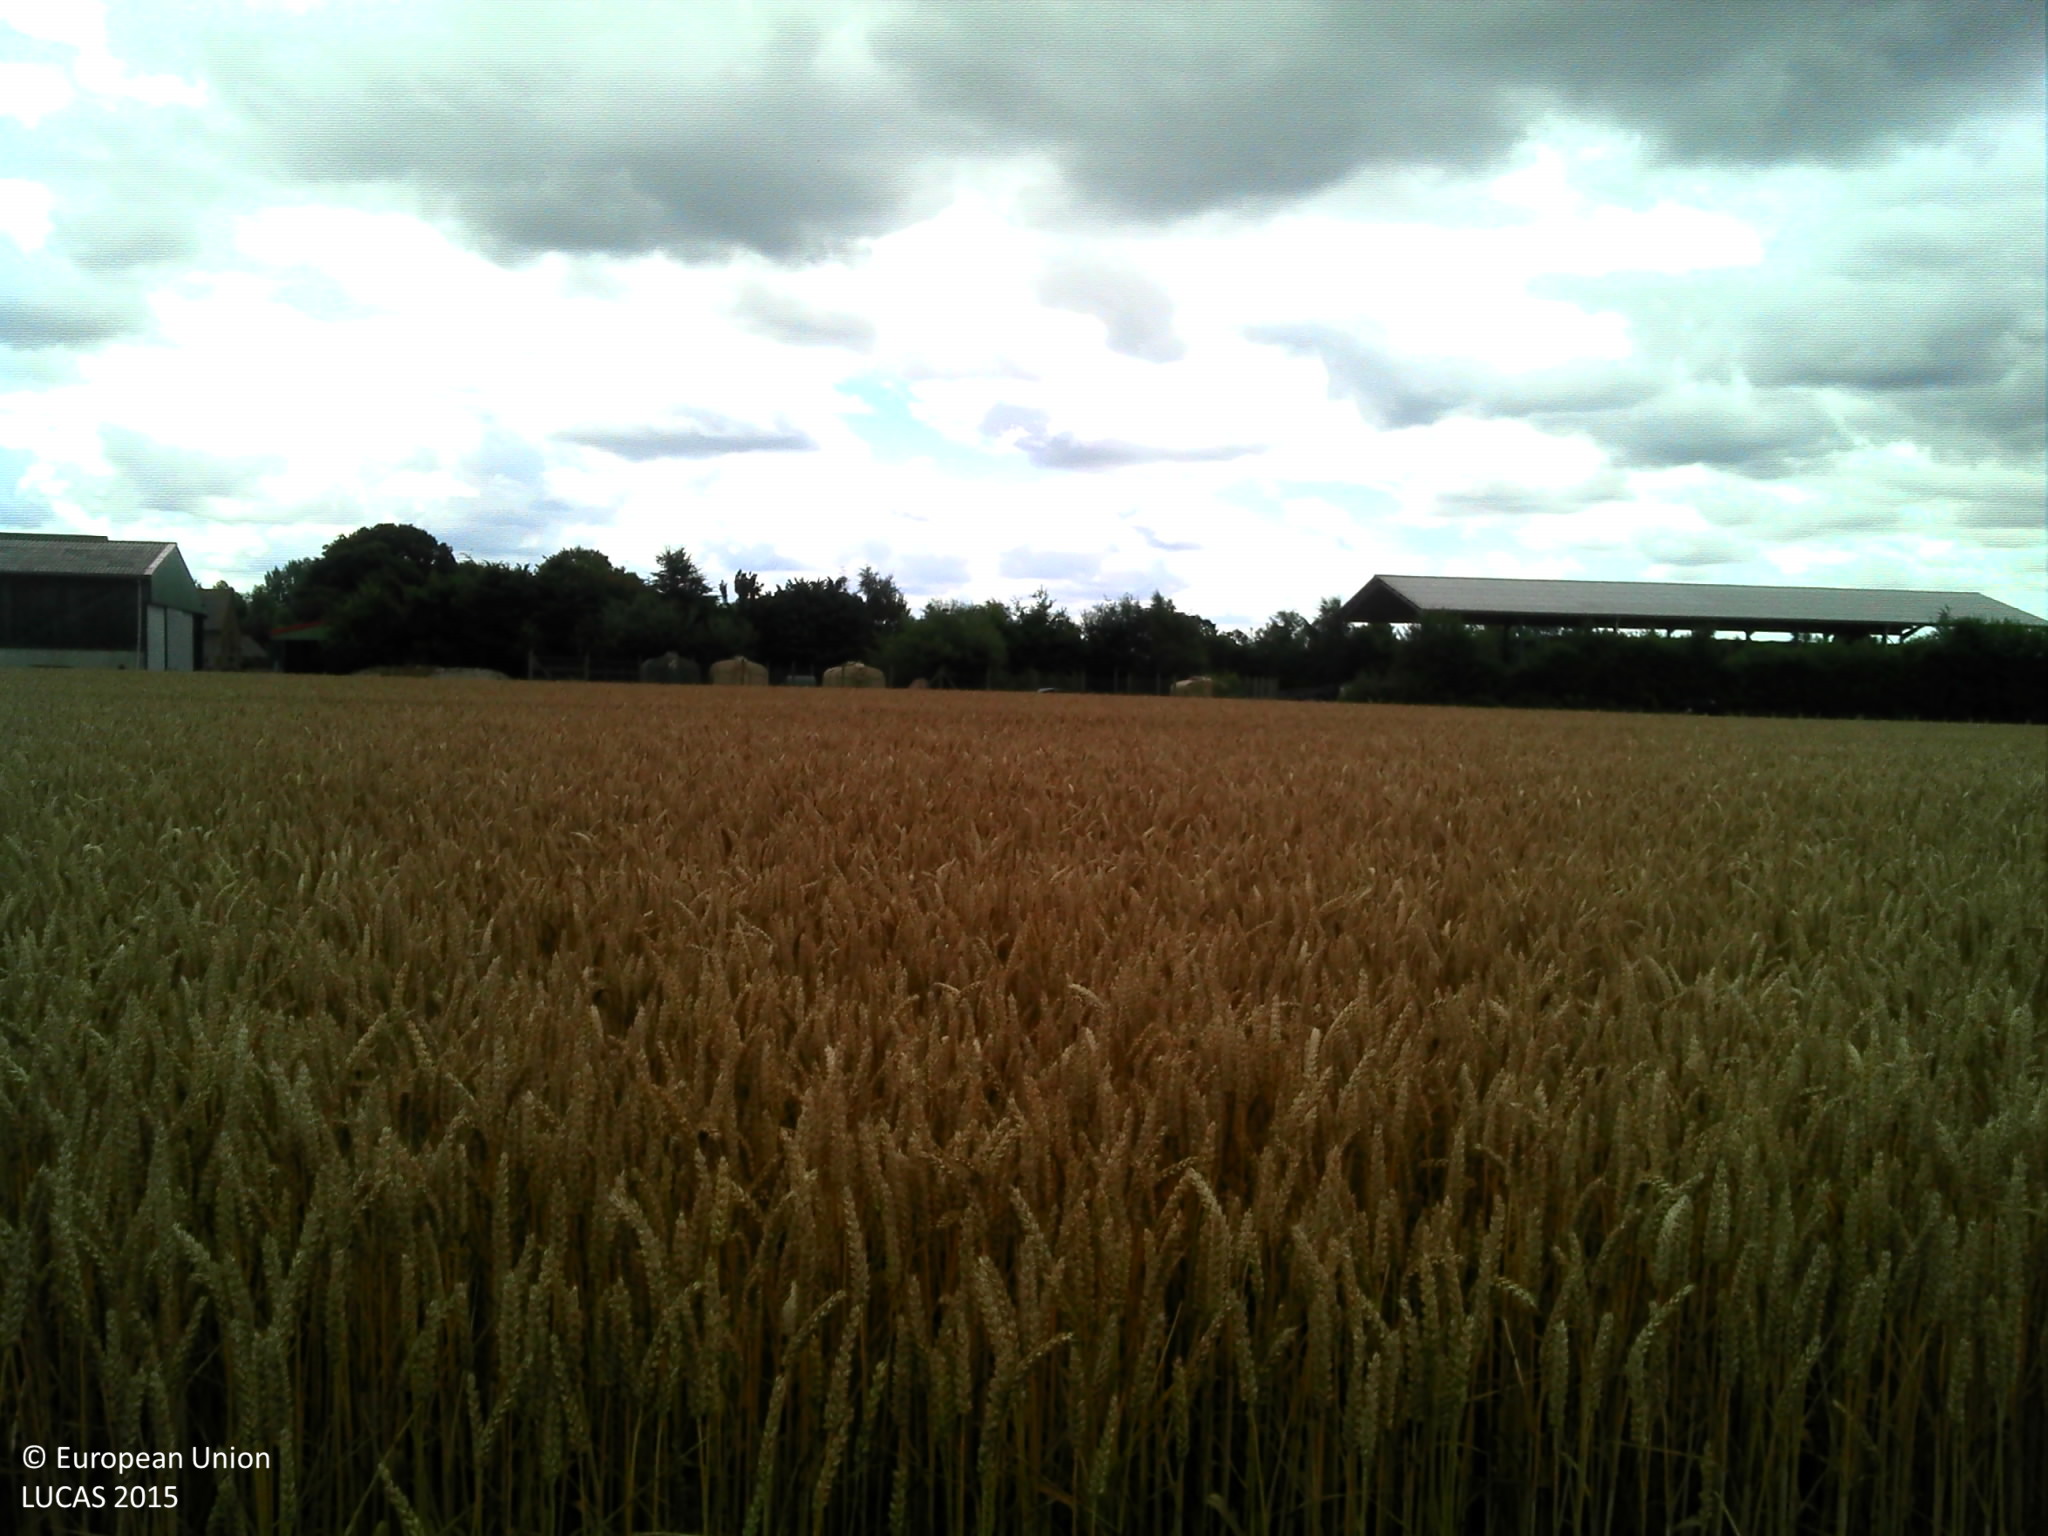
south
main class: Cropland
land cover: Common wheat
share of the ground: > 75 %
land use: Agriculture (excluding fallow land and kitchen gardens)
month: July
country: FR
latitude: 48.5158
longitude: -1.7884
